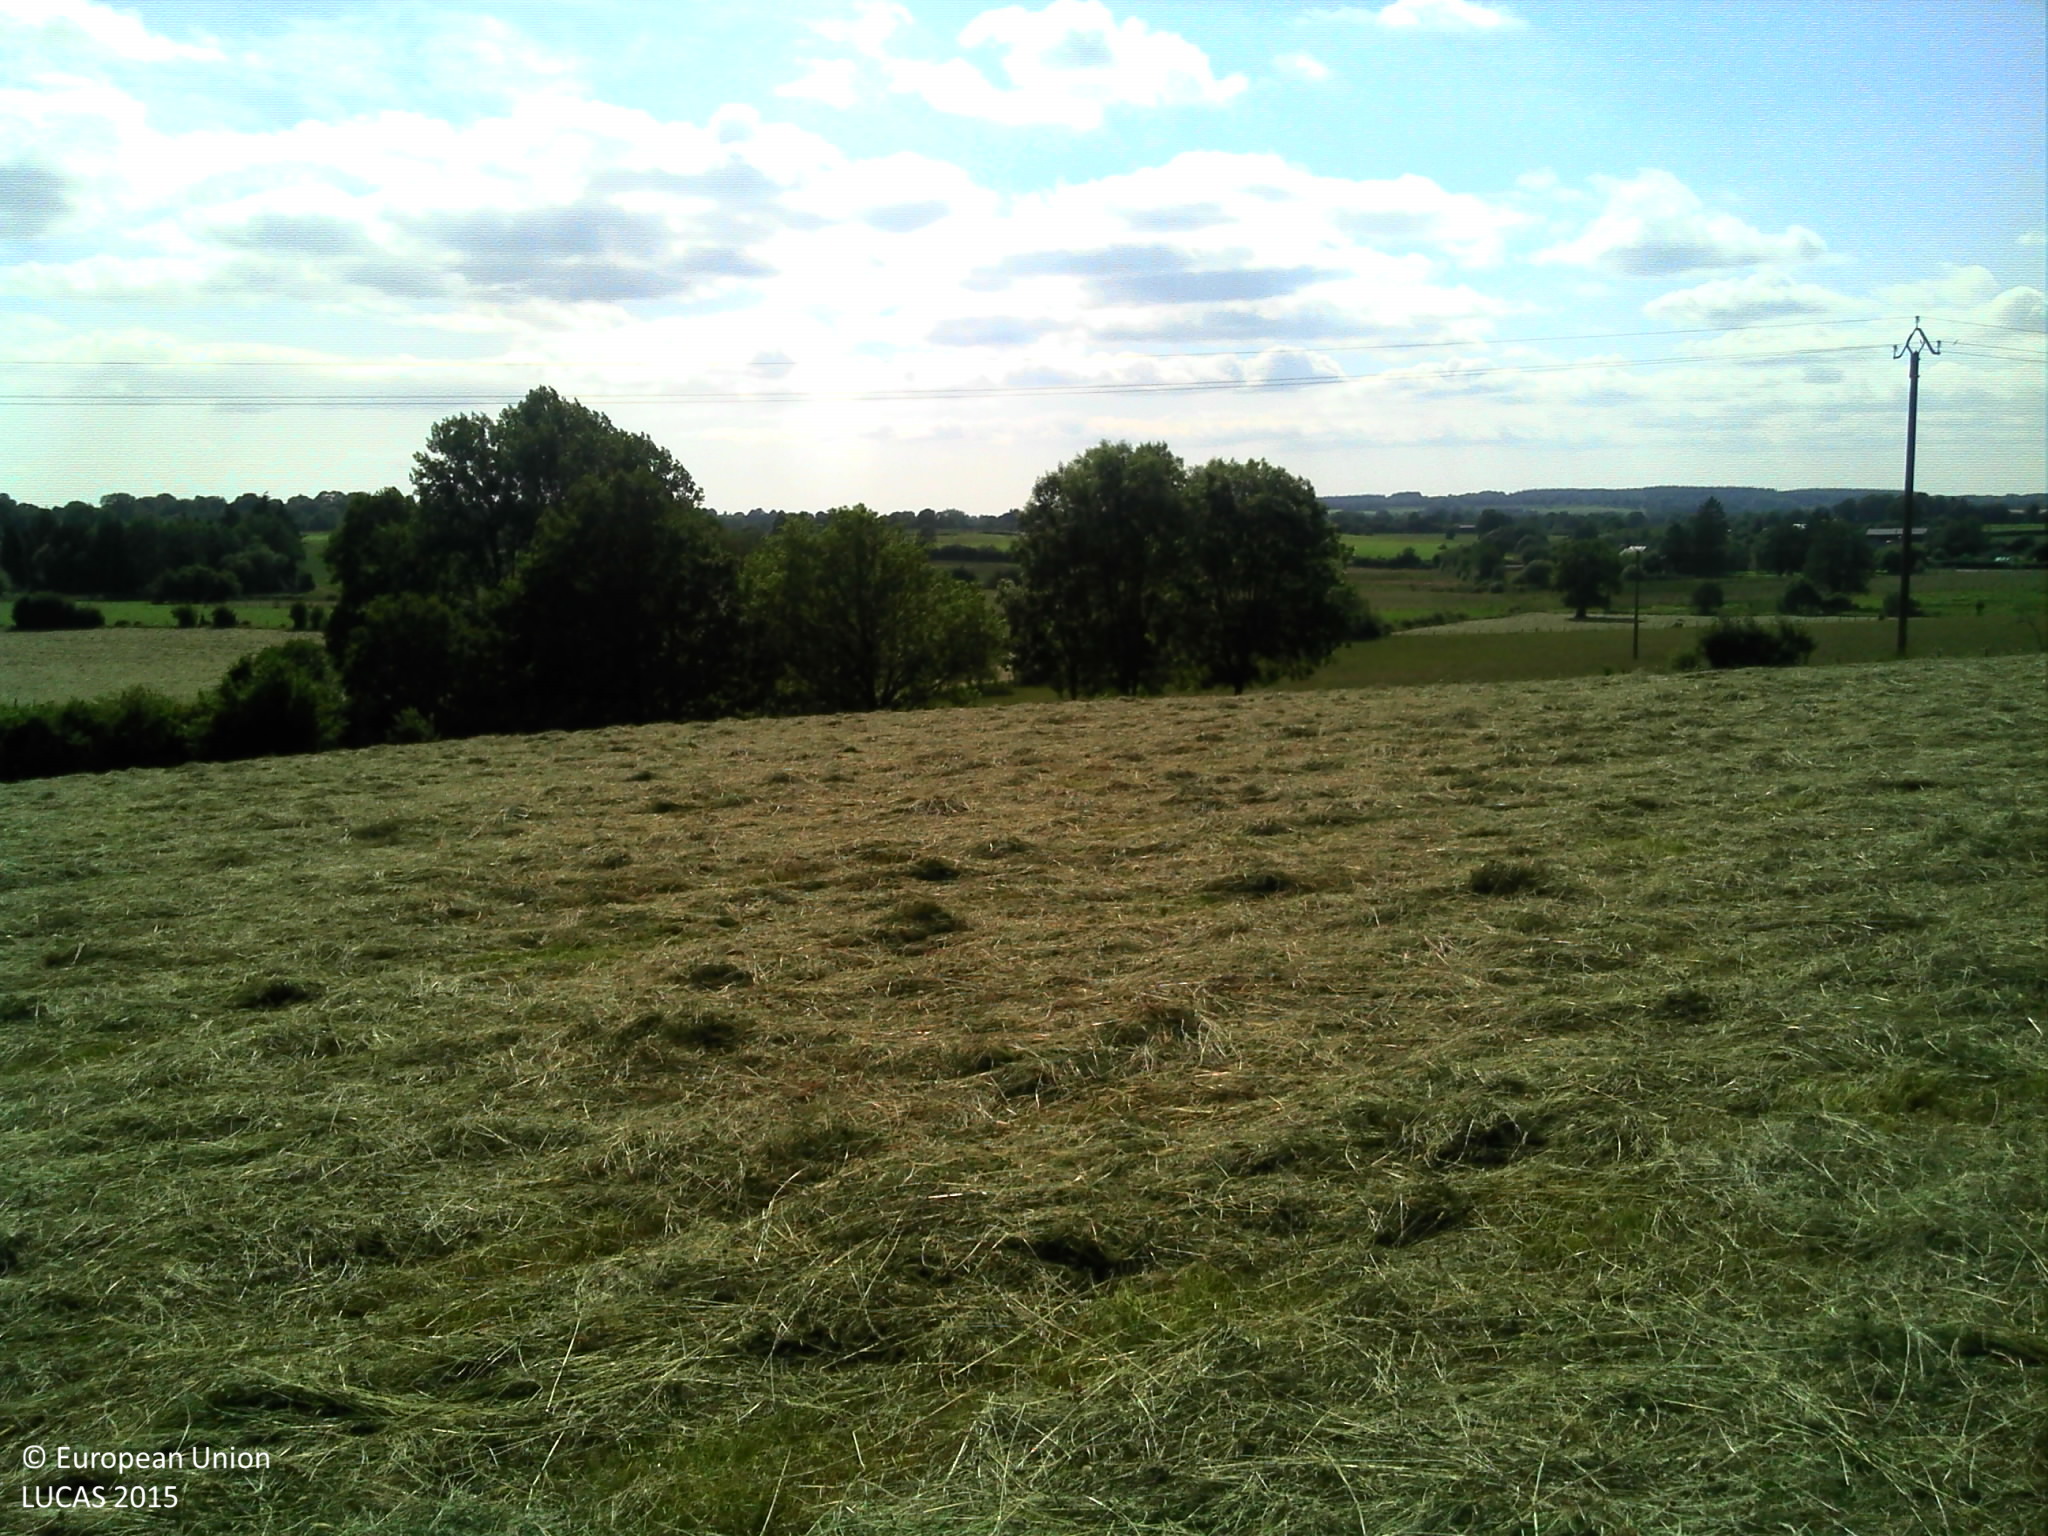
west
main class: Grassland
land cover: Grassland without tree/shrub cover
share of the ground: > 75 %
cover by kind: herbaceous plants 100 %
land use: Agriculture (excluding fallow land and kitchen gardens)
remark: Harvested field
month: June
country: FR
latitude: 48.5007
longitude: -0.1135
